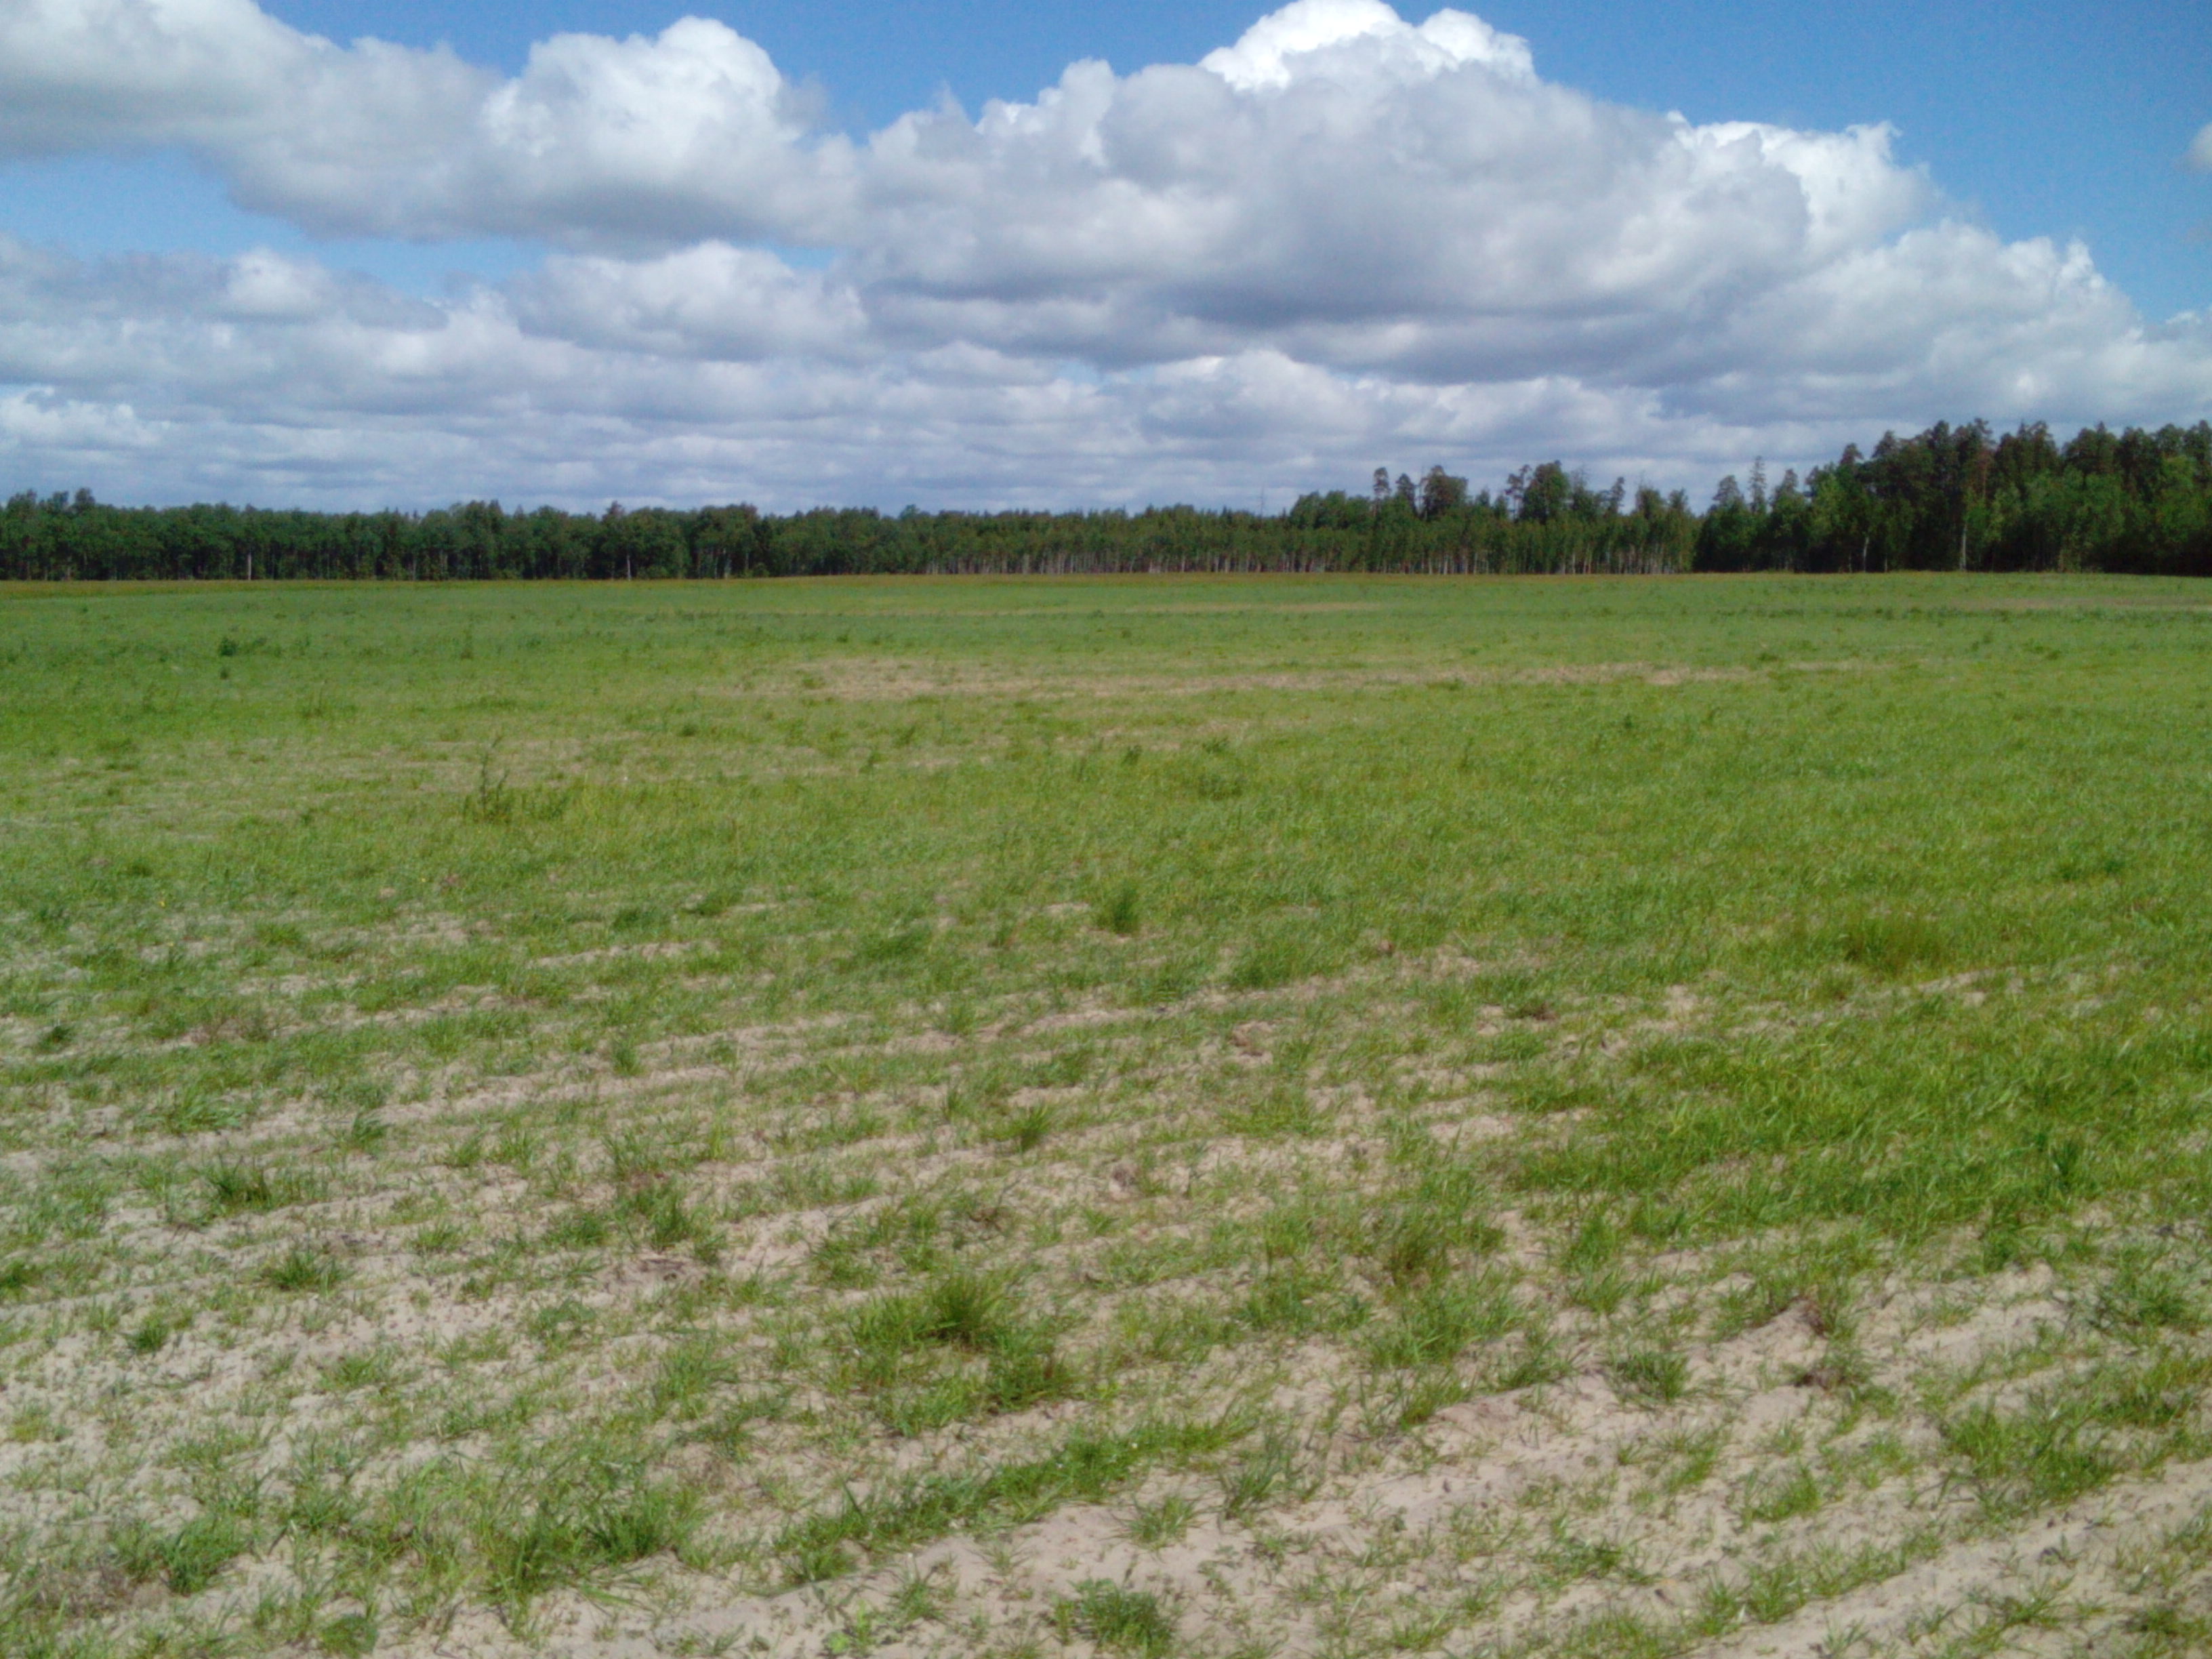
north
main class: Grassland
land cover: Spontaneously vegetated surfaces
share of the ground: 50 - 75 %
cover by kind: herbaceous plants 60 %, unconsolidated bare surface 40 %
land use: Fallow land
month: June
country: LV
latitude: 56.8182
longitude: 22.0576
